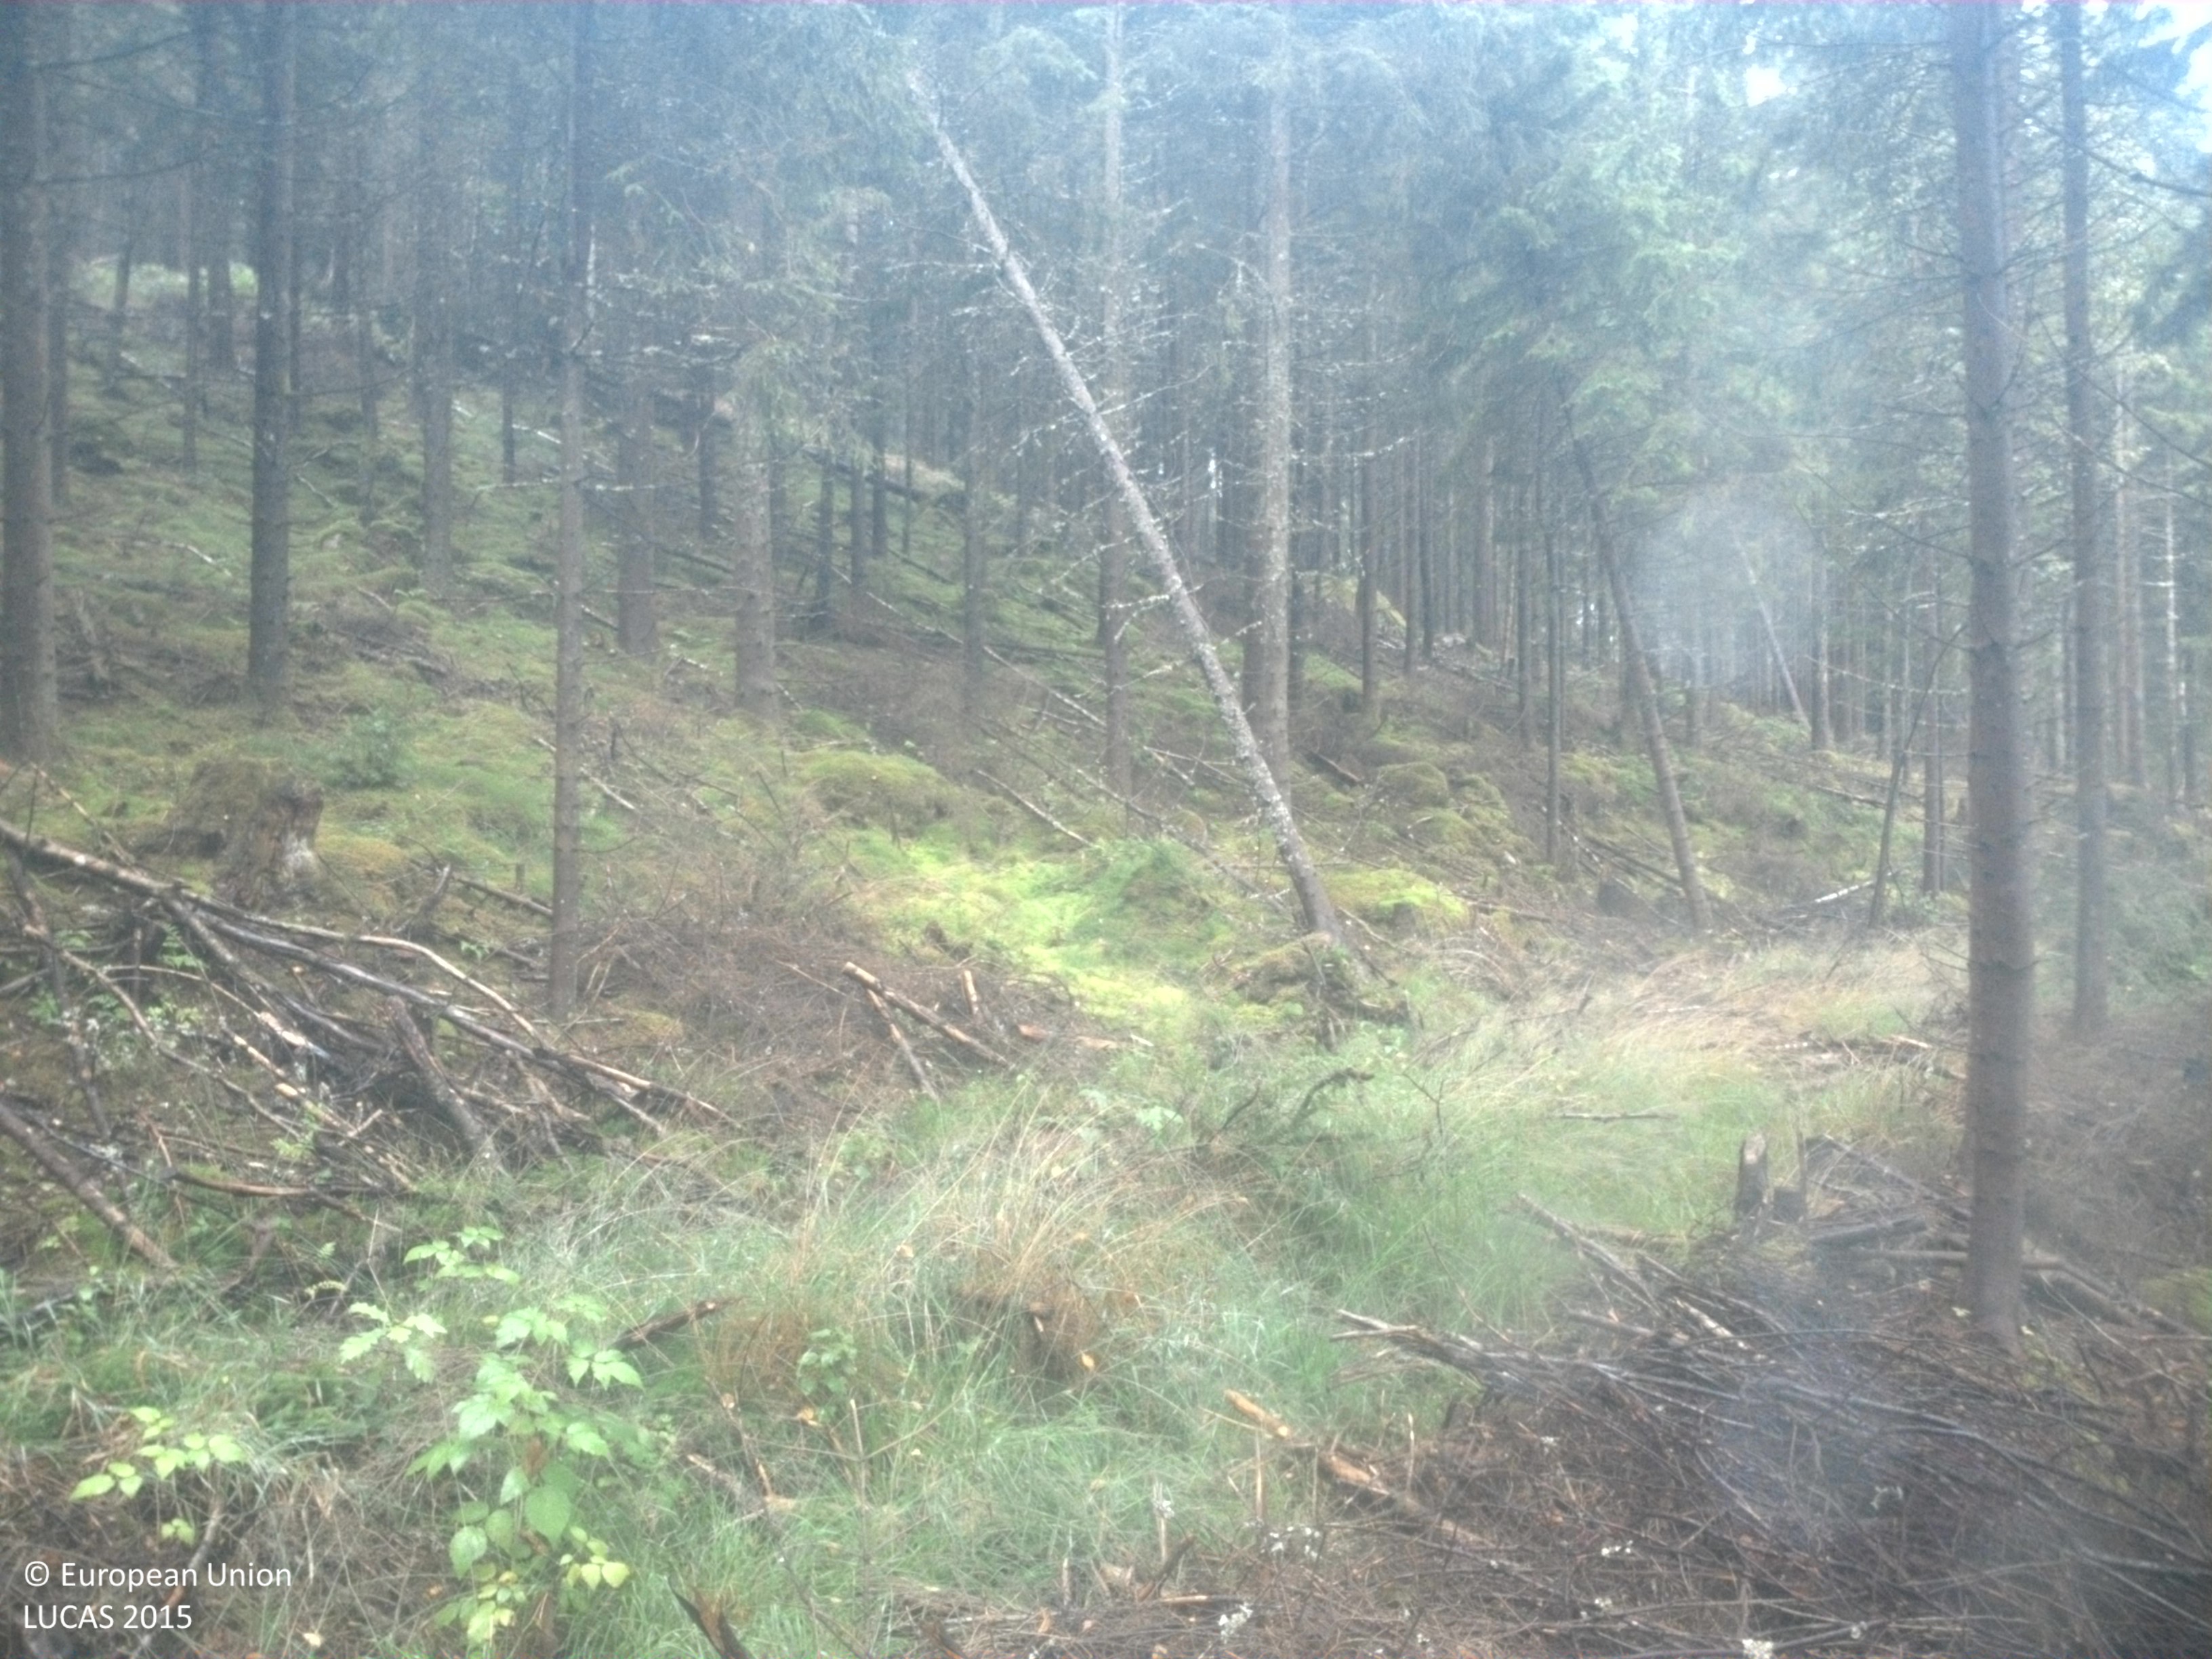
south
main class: Woodland
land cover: Spruce dominated coniferous woodland
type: boreal forest
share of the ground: 50 - 75 %
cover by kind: coniferous forest trees 60 %, lichens and mosses 20 %, herbaceous plants 10 %, broadleaved forest trees 5 %, shrubs 5 %
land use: Forestry
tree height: > 5 m
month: August
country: SE
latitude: 57.7298
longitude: 13.2699
